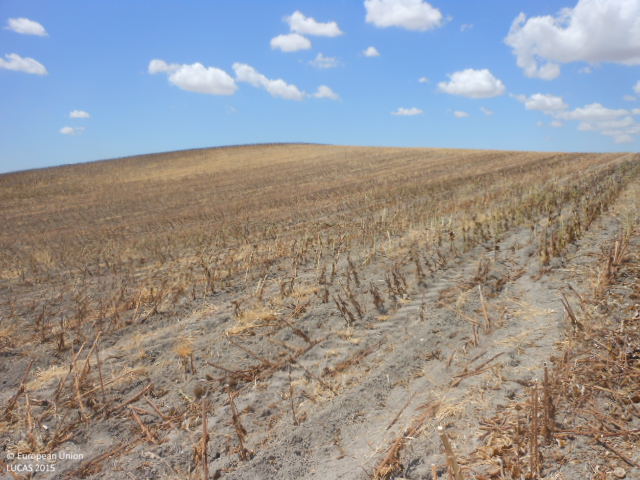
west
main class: Cropland
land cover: Sunflower
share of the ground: < 10 %
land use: Agriculture (excluding fallow land and kitchen gardens)
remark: Harvested field
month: July
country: ES
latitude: 37.4074
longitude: -5.3907
